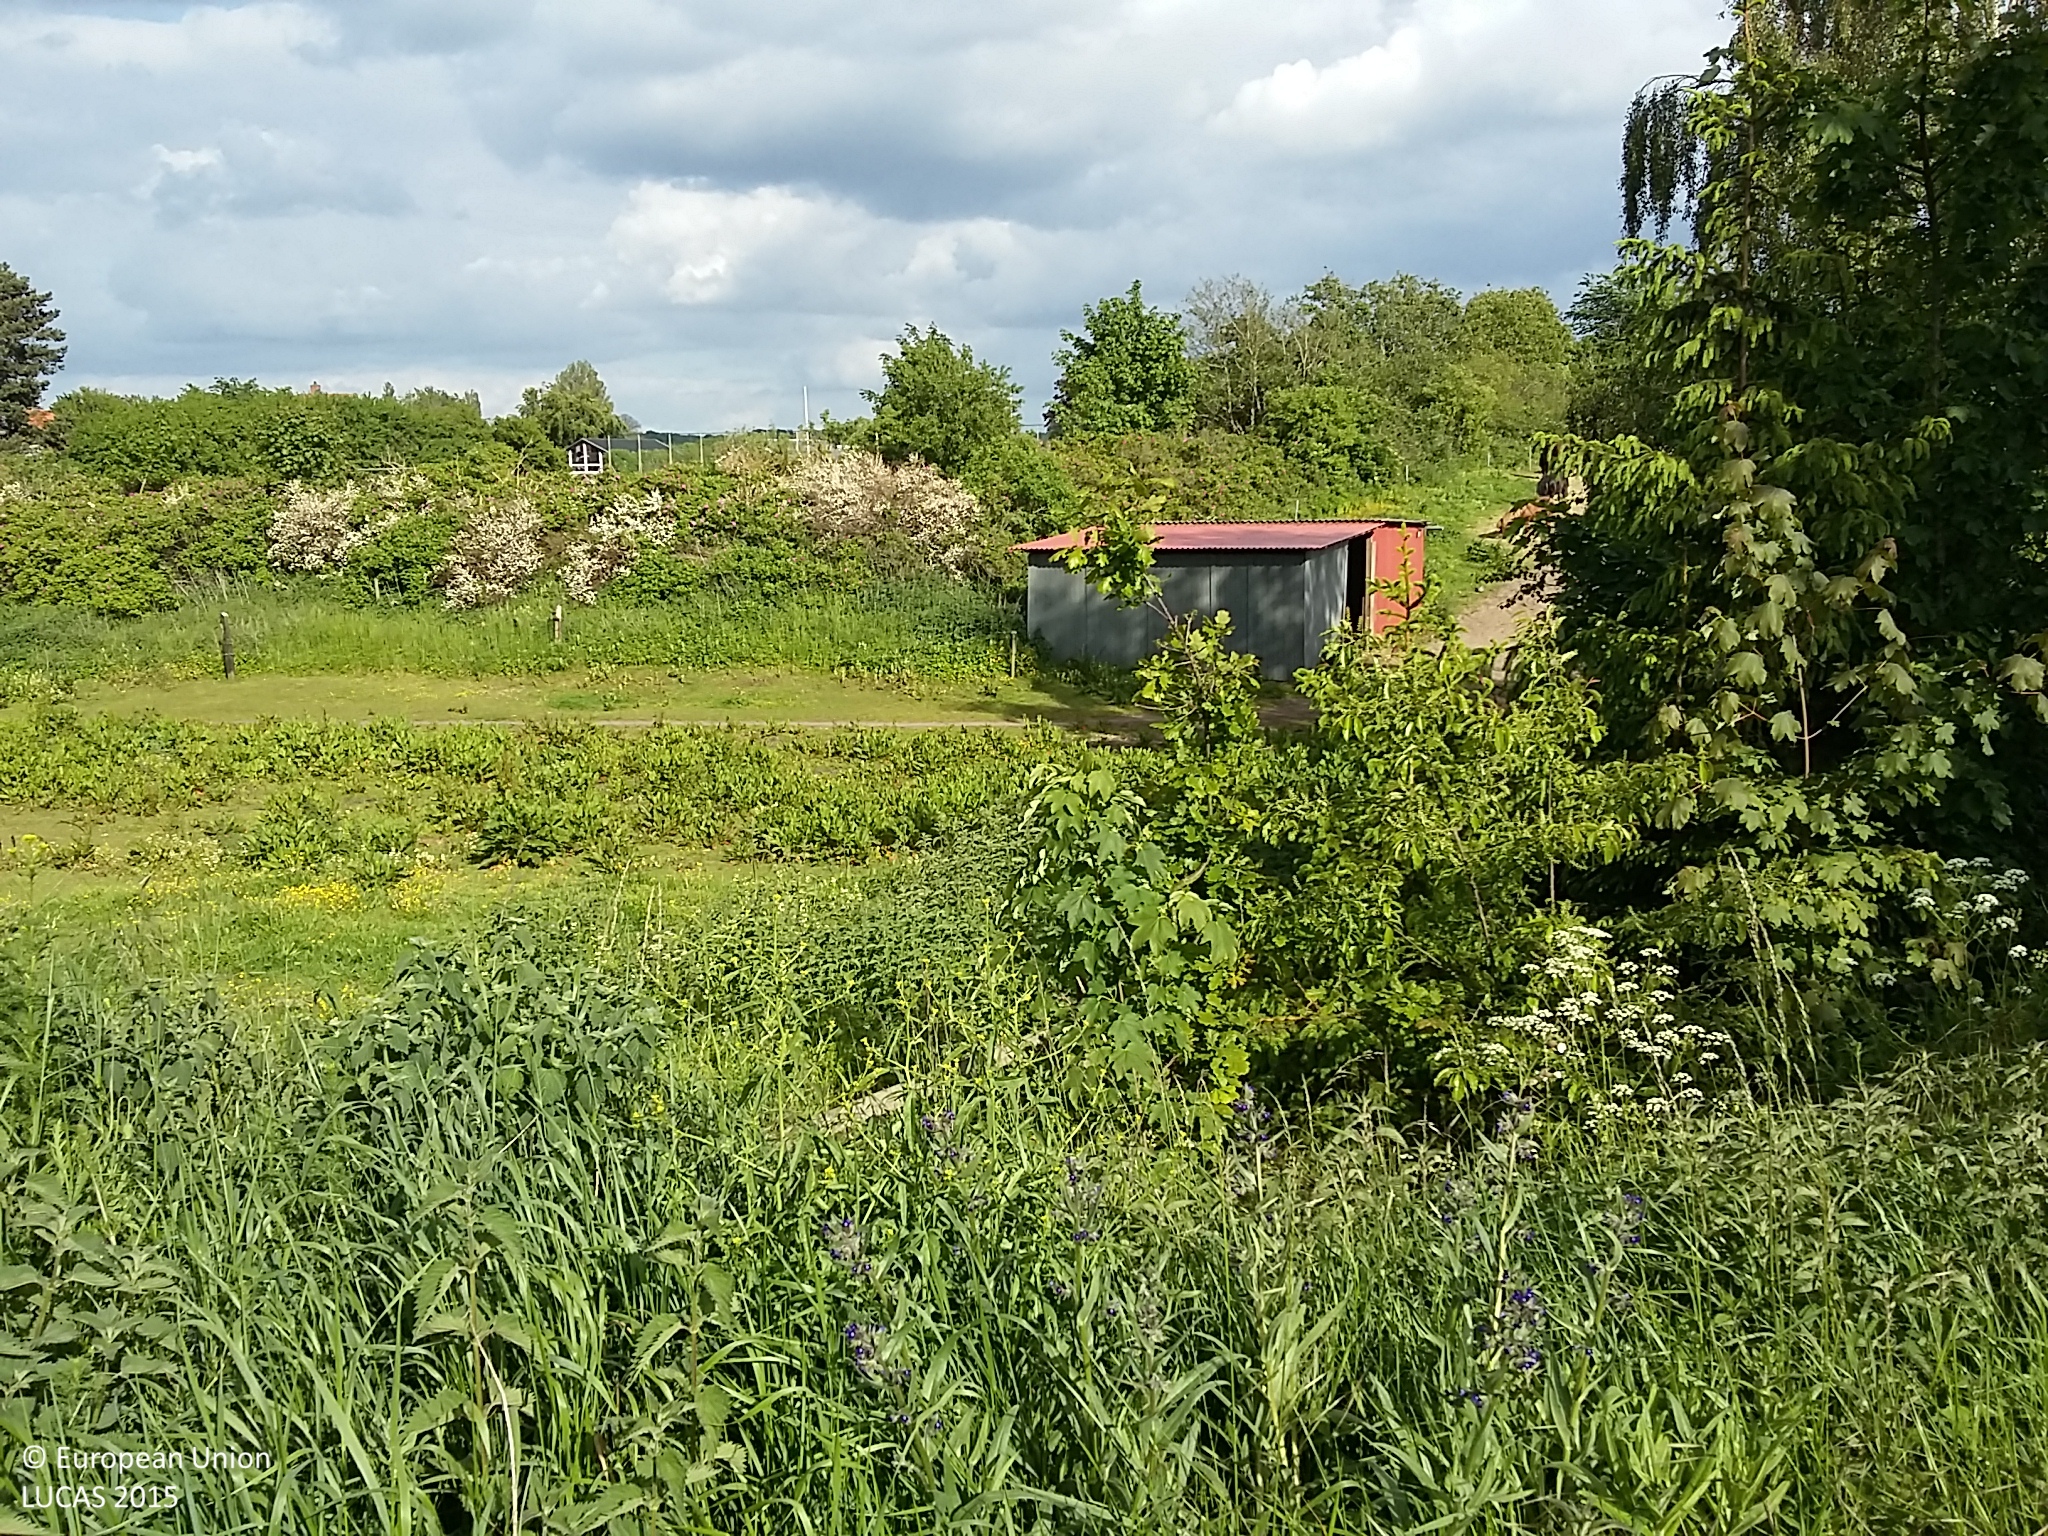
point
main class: Woodland
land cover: Broadleaved woodland
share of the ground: > 75 %
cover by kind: herbaceous plants 60 %, broadleaved forest trees 40 %
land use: Agriculture (excluding fallow land and kitchen gardens)
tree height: > 5 m
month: June
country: DK
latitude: 55.3408
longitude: 10.7404
